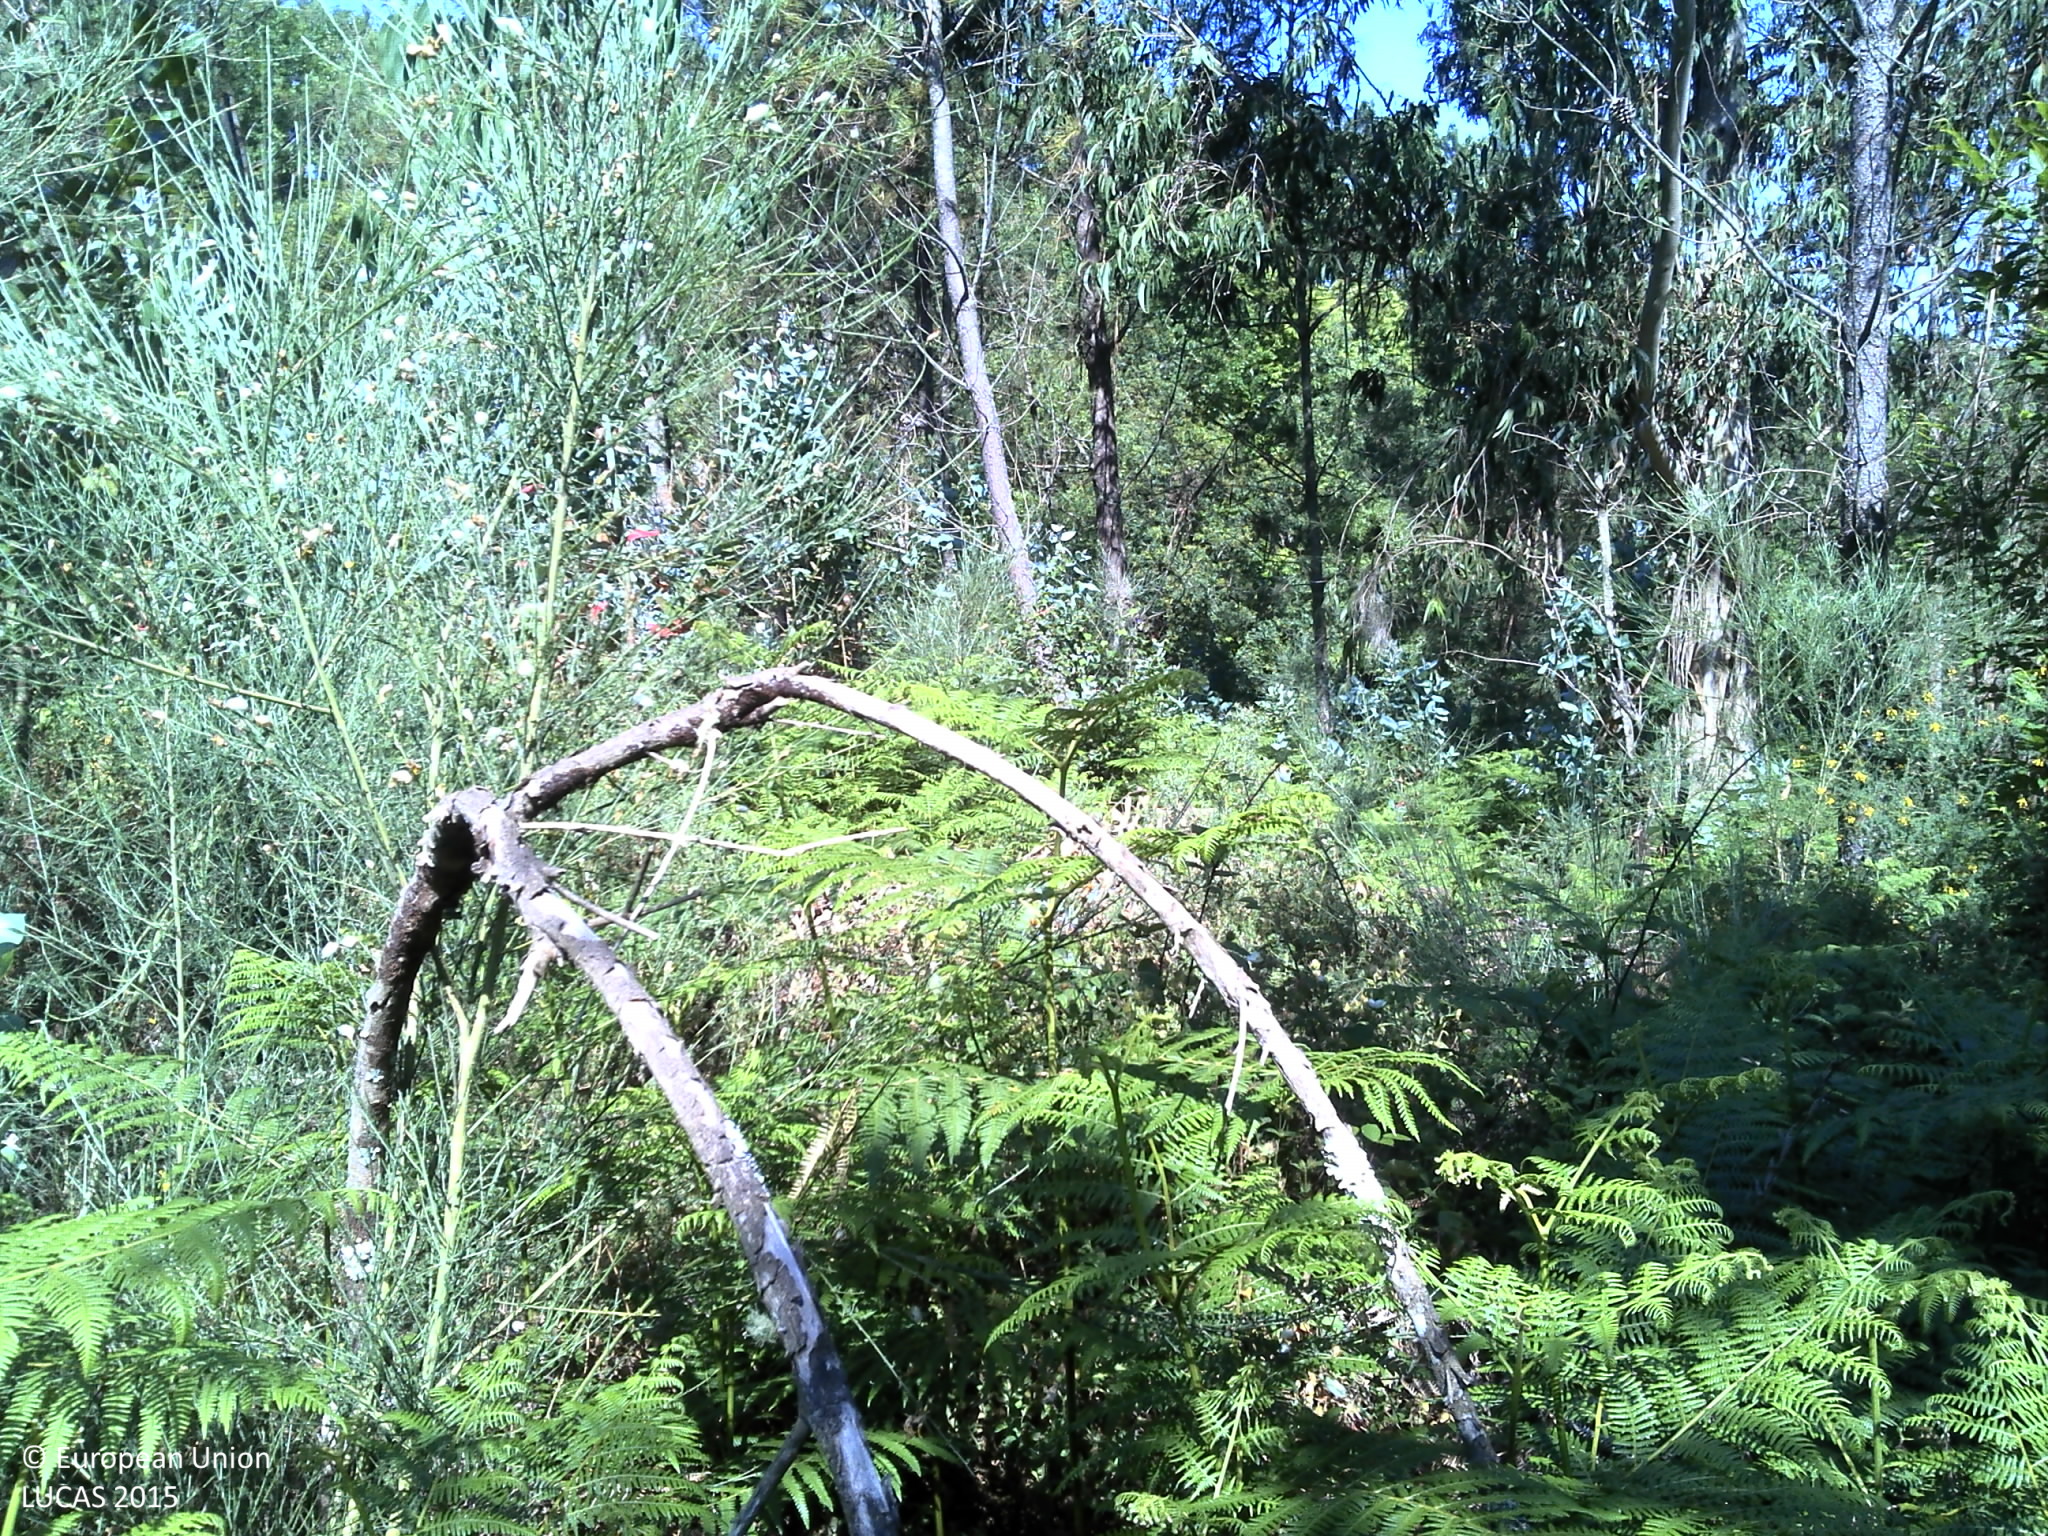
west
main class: Woodland
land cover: Pine dominated mixed woodland
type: coniferous forest of the mediterranean region
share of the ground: 50 - 75 %
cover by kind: coniferous forest trees 75 %, broadleaved forest trees 25 %
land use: Forestry
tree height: > 5 m
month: June
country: PT
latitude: 41.8462
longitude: -8.4541
